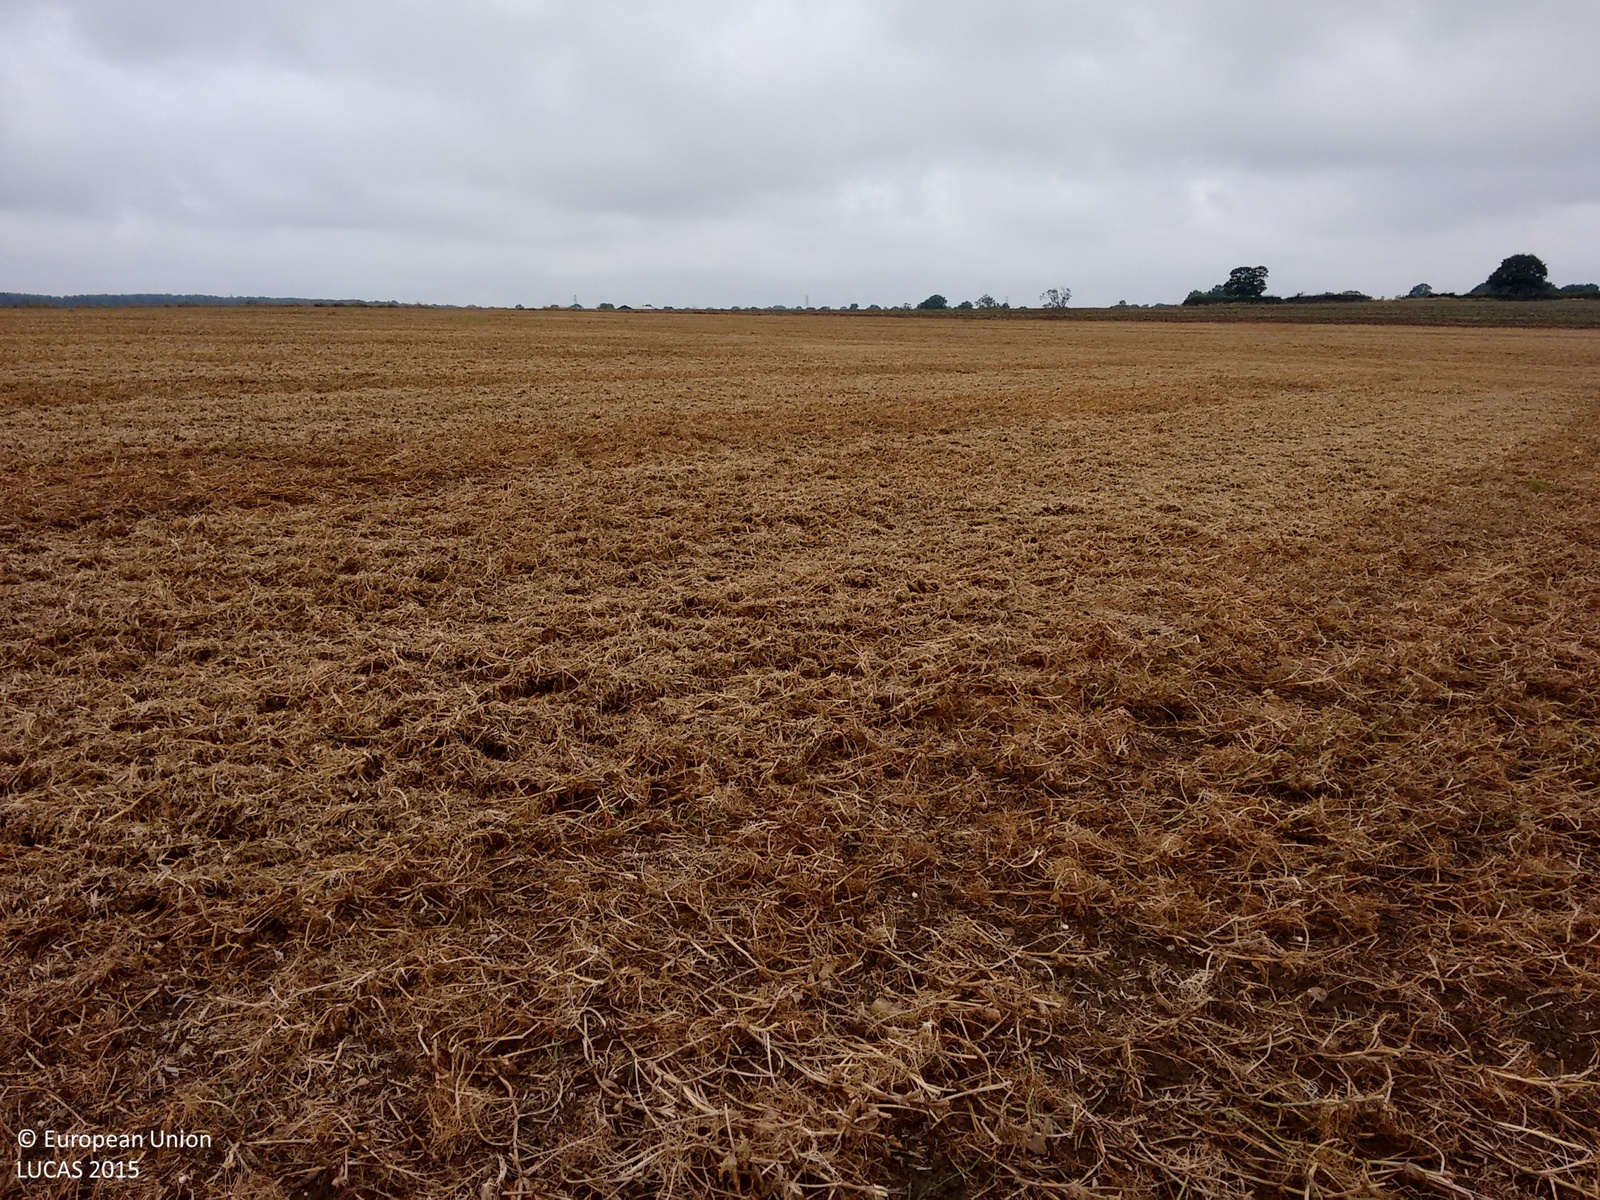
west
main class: Cropland
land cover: Dry pulses
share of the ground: > 75 %
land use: Agriculture (excluding fallow land and kitchen gardens)
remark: Harvested field
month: September
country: GB
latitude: 52.4734
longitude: -1.2807
